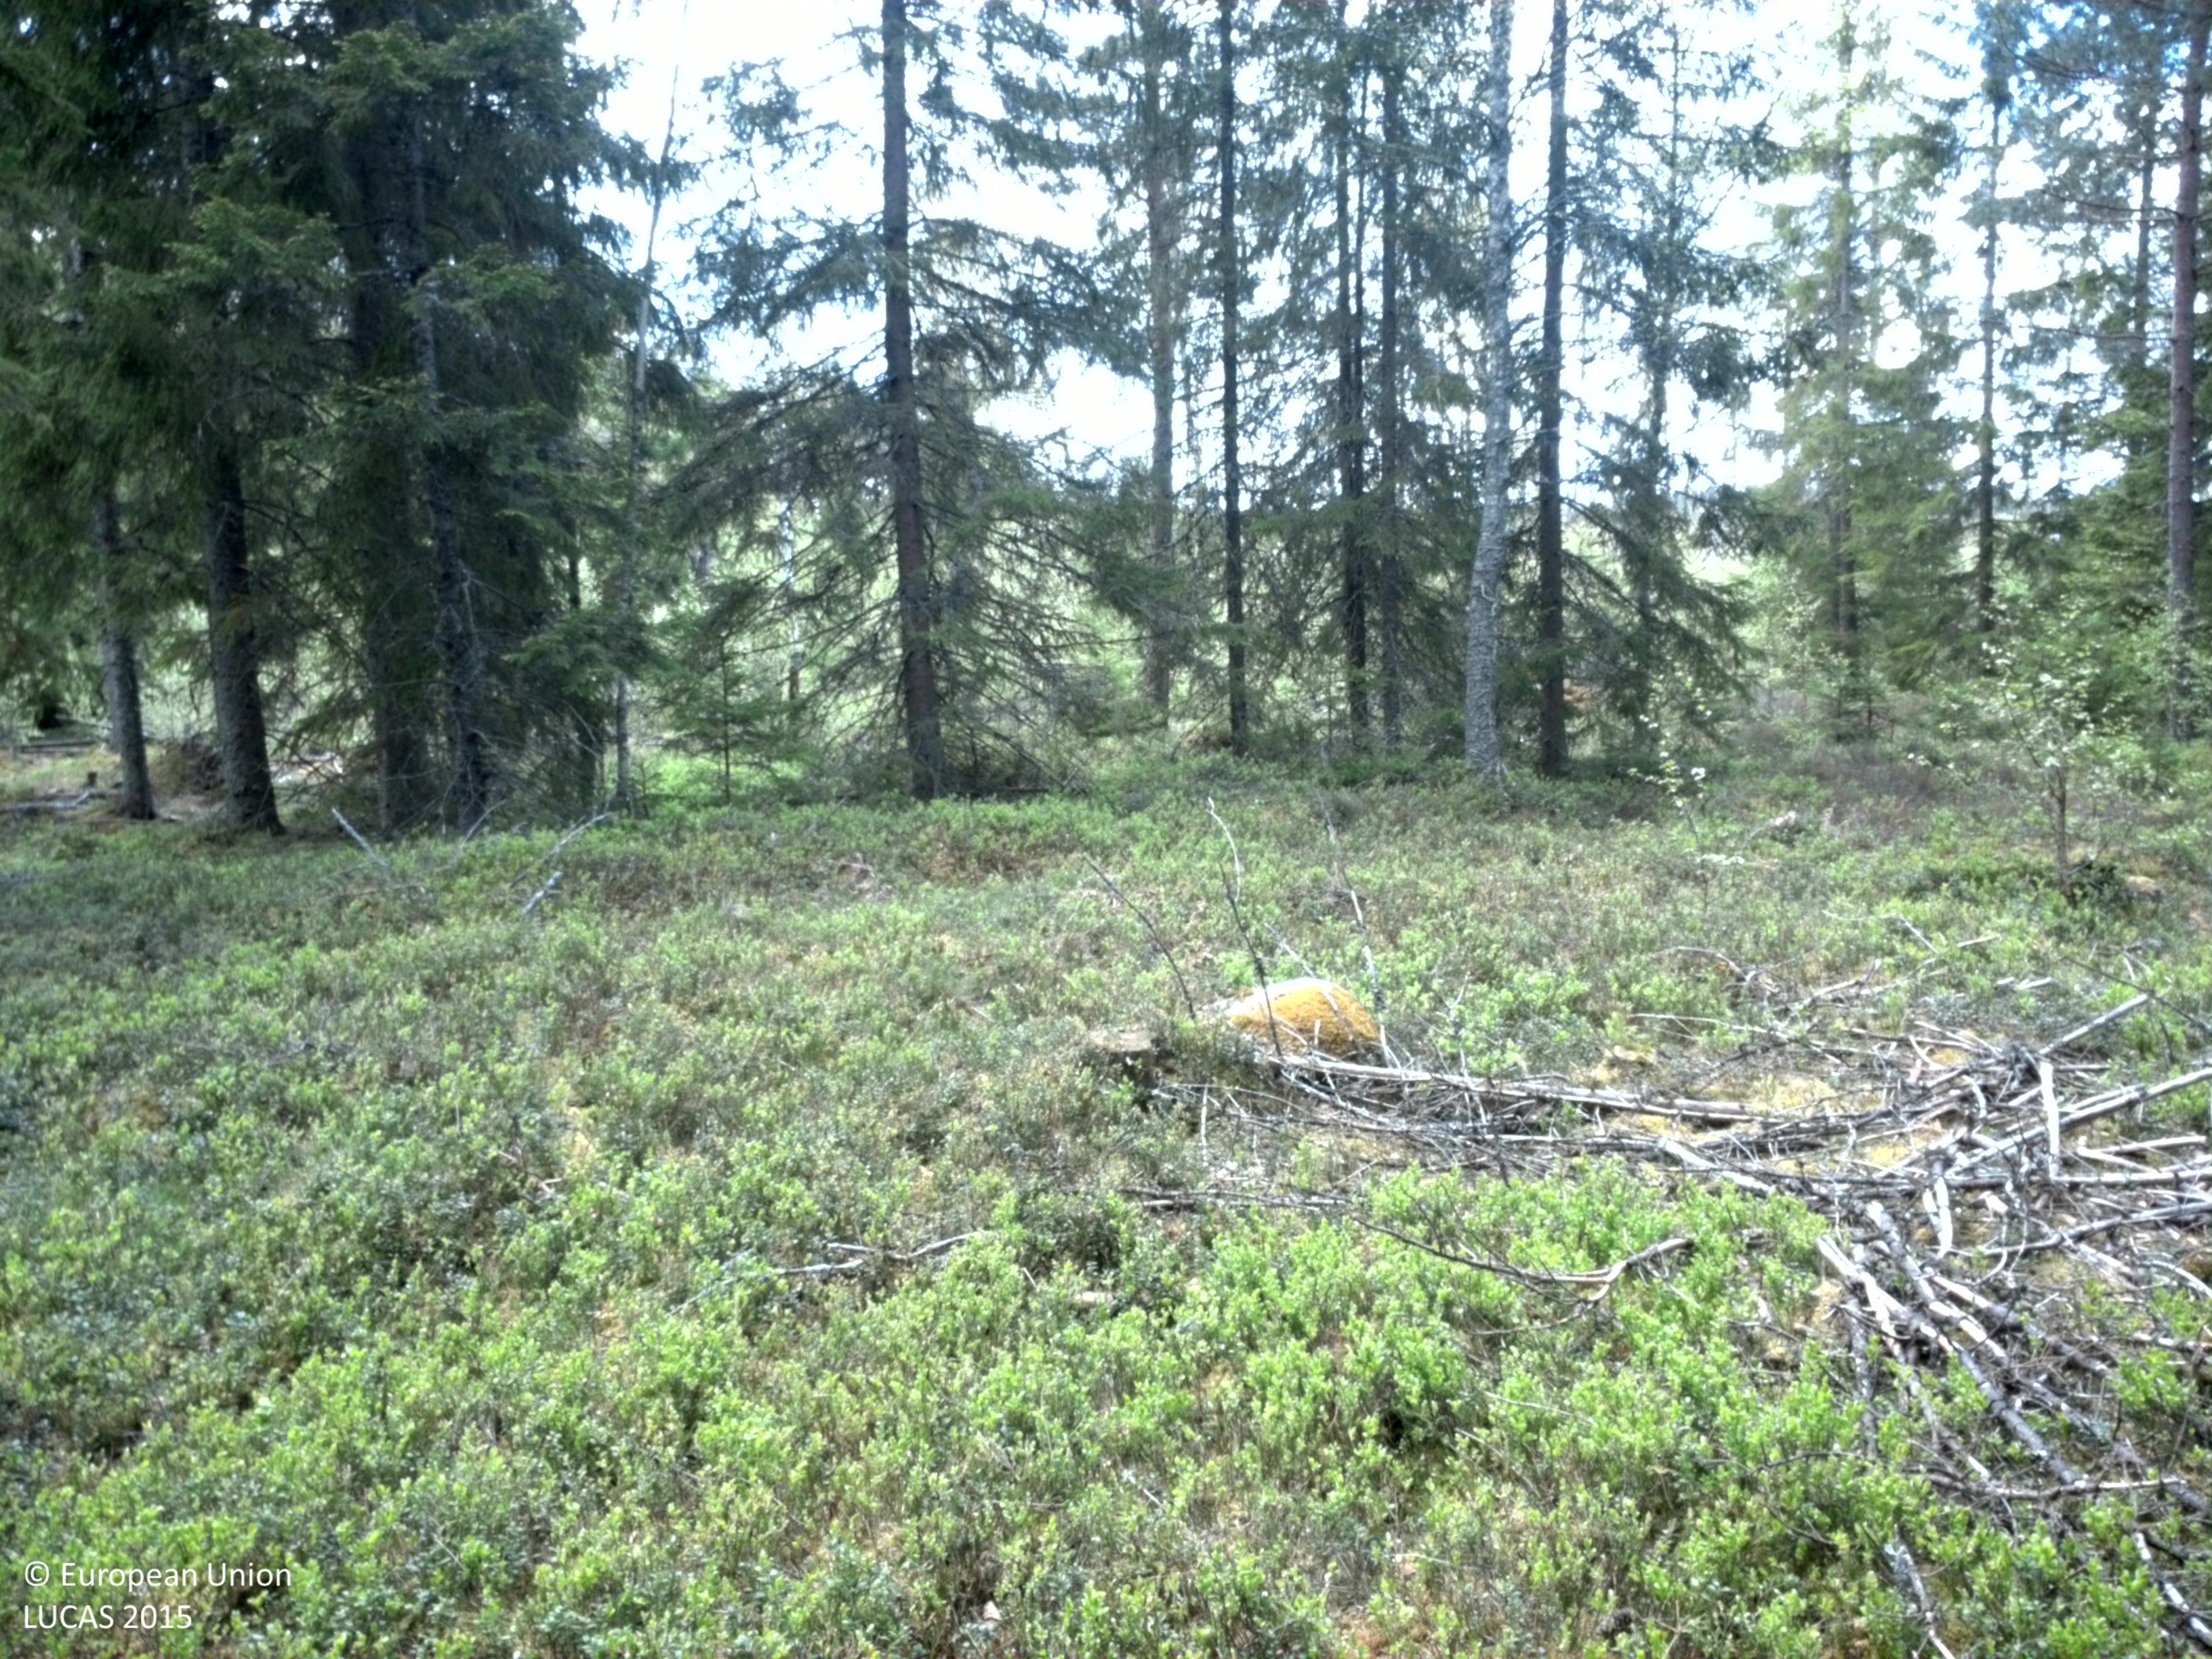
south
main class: Woodland
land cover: Spruce dominated coniferous woodland
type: boreal forest
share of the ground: 50 - 75 %
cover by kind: coniferous forest trees 60 %, shrubs 15 %, lichens and mosses 15 %, broadleaved forest trees 10 %
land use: Forestry
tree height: > 5 m
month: May
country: SE
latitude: 56.7818
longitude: 15.2845
